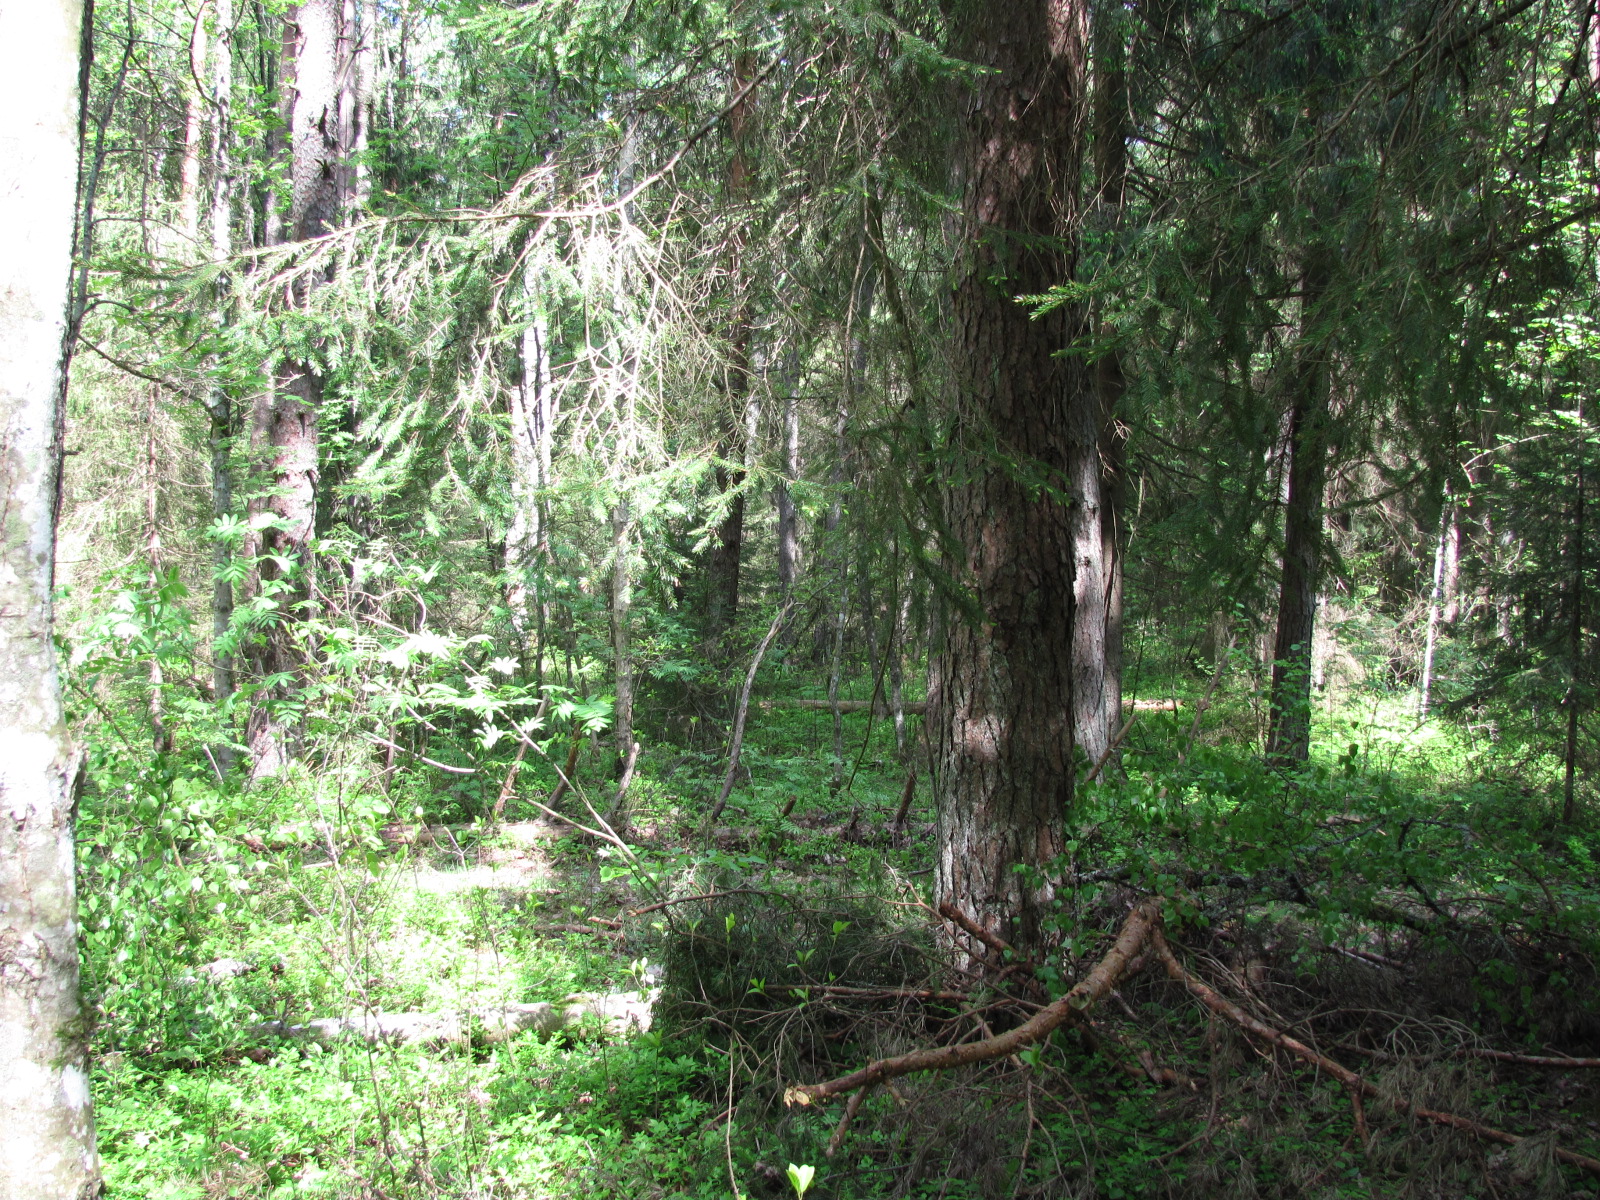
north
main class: Woodland
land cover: Other mixed woodland
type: hemiboreal forest and nemoral coniferous forest and mixed broadleaved-coniferous forest
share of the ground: > 75 %
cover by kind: coniferous forest trees 70 %, broadleaved forest trees 25 %, herbaceous plants 5 %
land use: Forestry
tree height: > 5 m
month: May
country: LV
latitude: 56.8090
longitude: 24.4578
